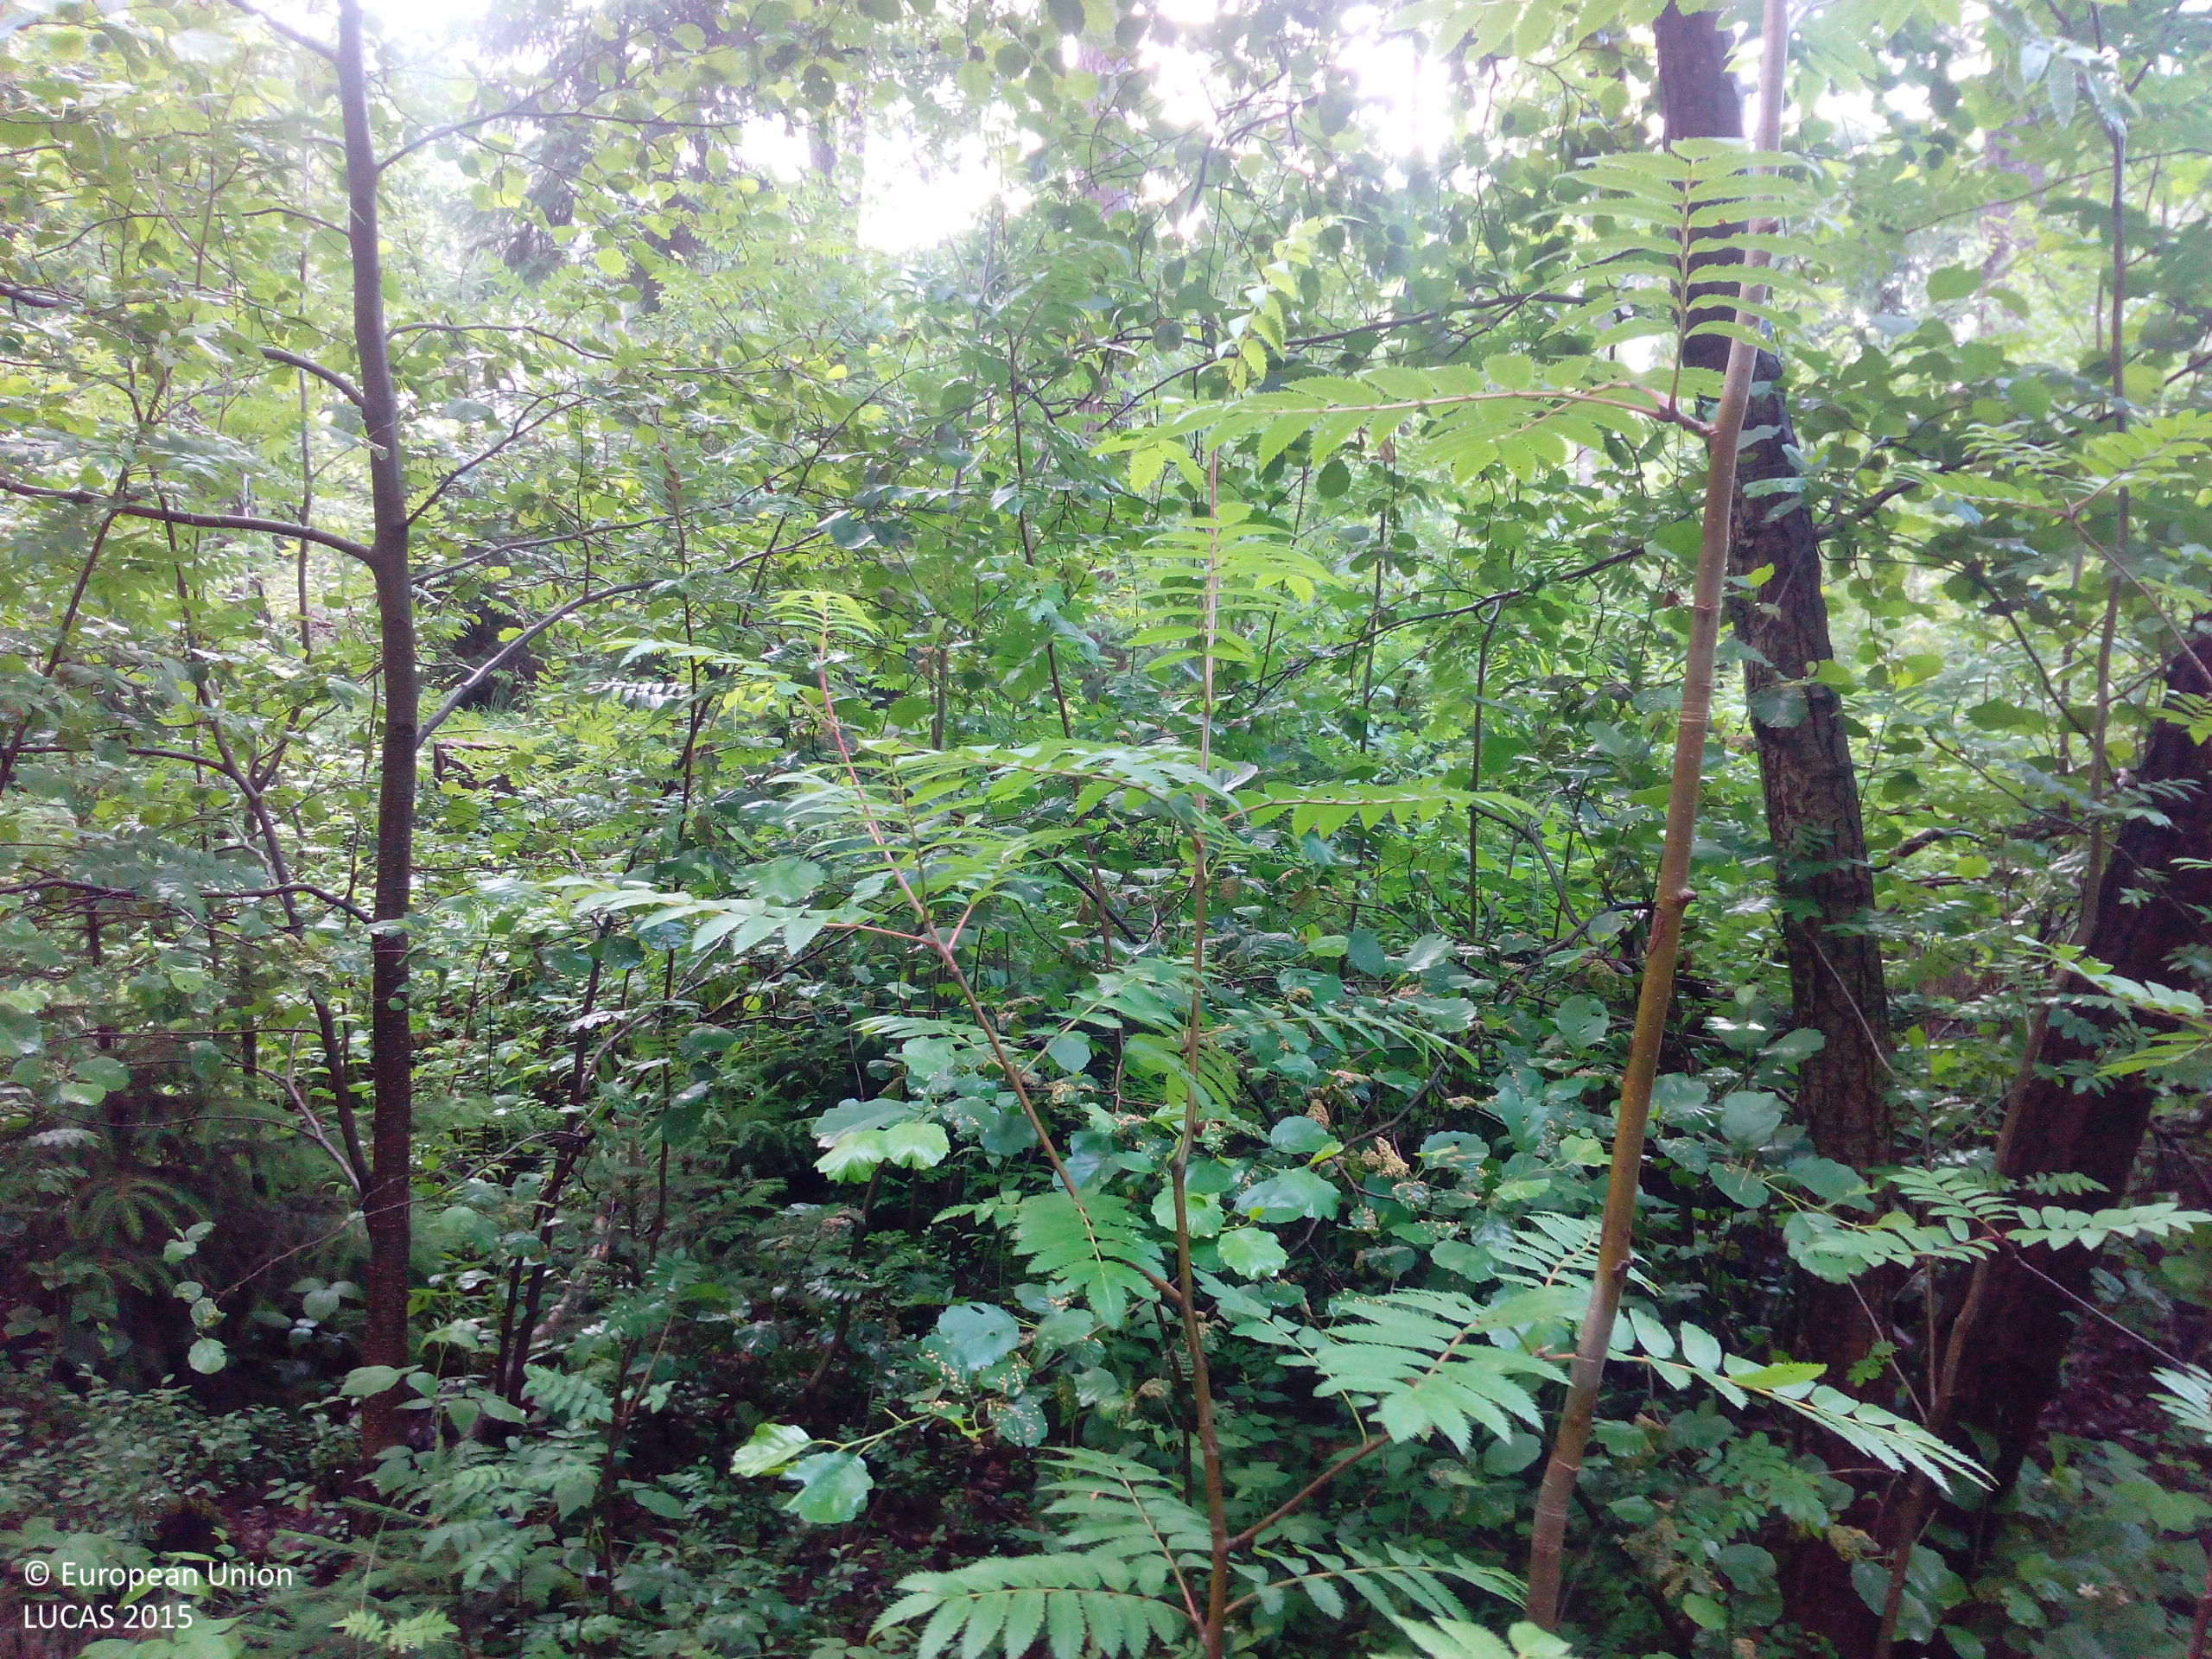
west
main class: Woodland
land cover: Spruce dominated mixed woodland
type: hemiboreal forest and nemoral coniferous forest and mixed broadleaved-coniferous forest
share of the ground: > 75 %
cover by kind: broadleaved forest trees 55 %, coniferous forest trees 25 %, shrubs 20 %
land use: Forestry
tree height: > 5 m
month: June
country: DE
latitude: 51.1945
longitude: 13.9934
